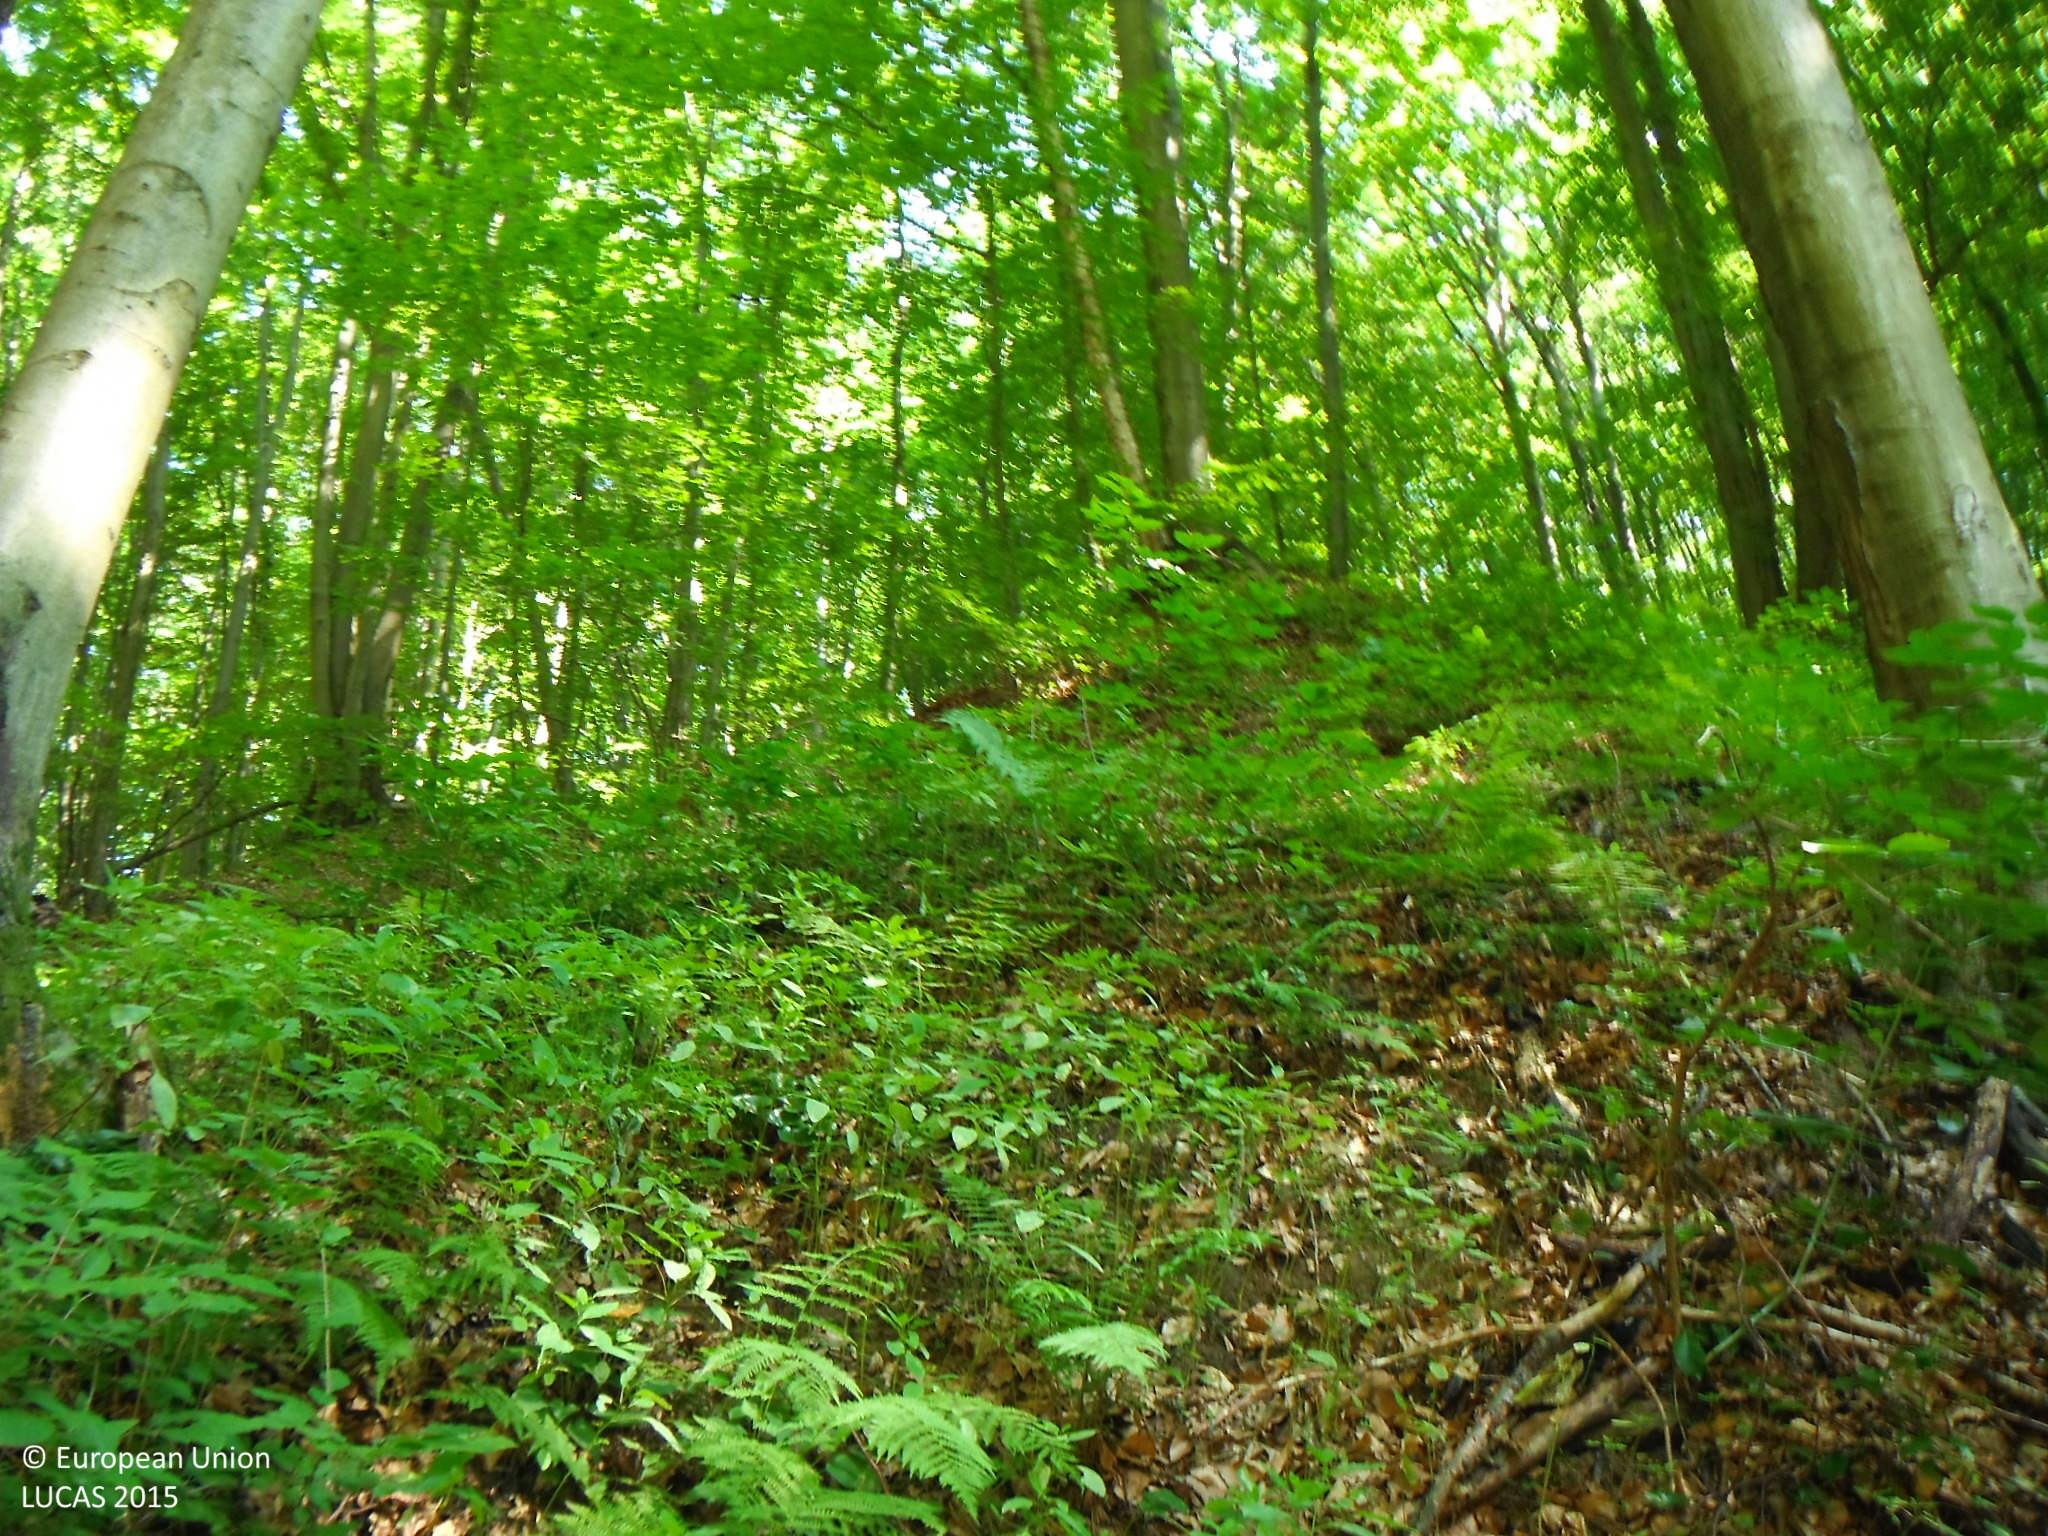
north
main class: Woodland
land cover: Broadleaved woodland
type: beech forest
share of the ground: > 75 %
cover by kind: broadleaved forest trees 90 %, herbaceous plants 10 %
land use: Forestry
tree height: > 5 m
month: July
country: SK
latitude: 49.2612
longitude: 21.4395
